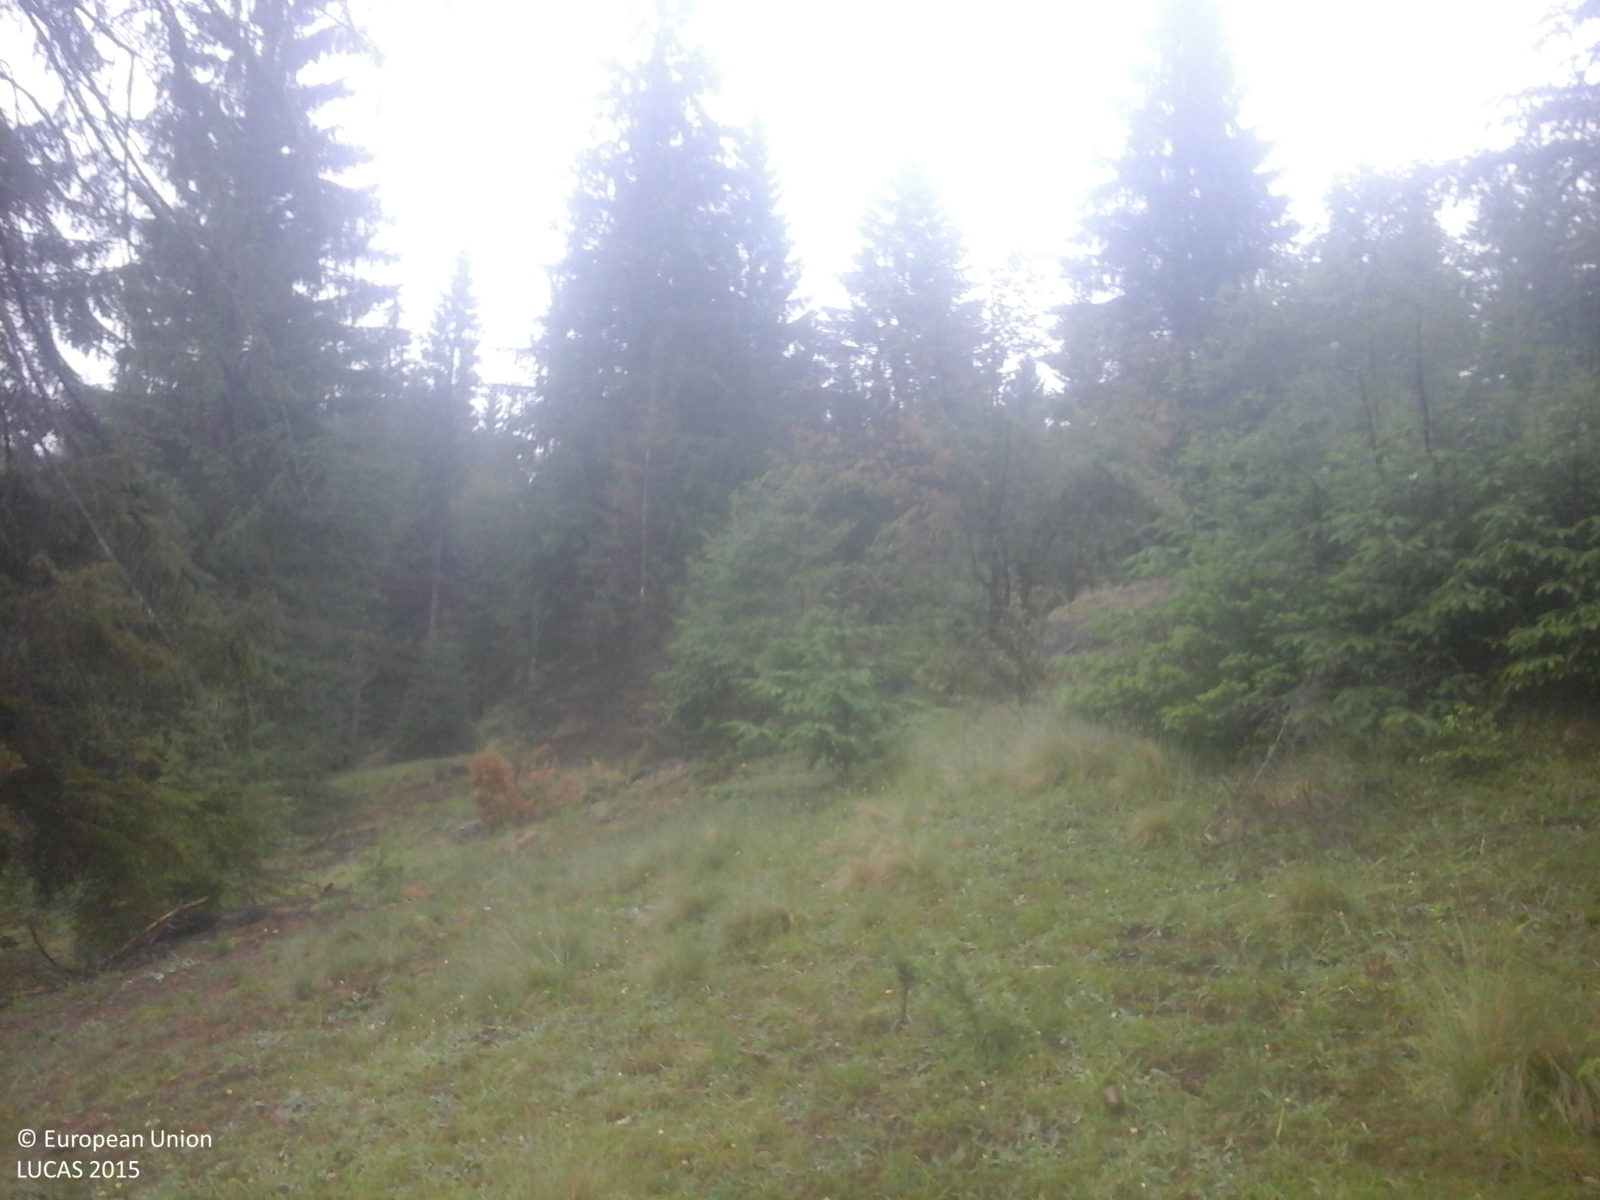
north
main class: Woodland
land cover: Spruce dominated coniferous woodland
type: alpine coniferous forest
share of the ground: > 75 %
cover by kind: coniferous forest trees 80 %, broadleaved forest trees 20 %
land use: Forestry
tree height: > 5 m
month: June
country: RO
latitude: 47.4322
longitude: 25.8621
